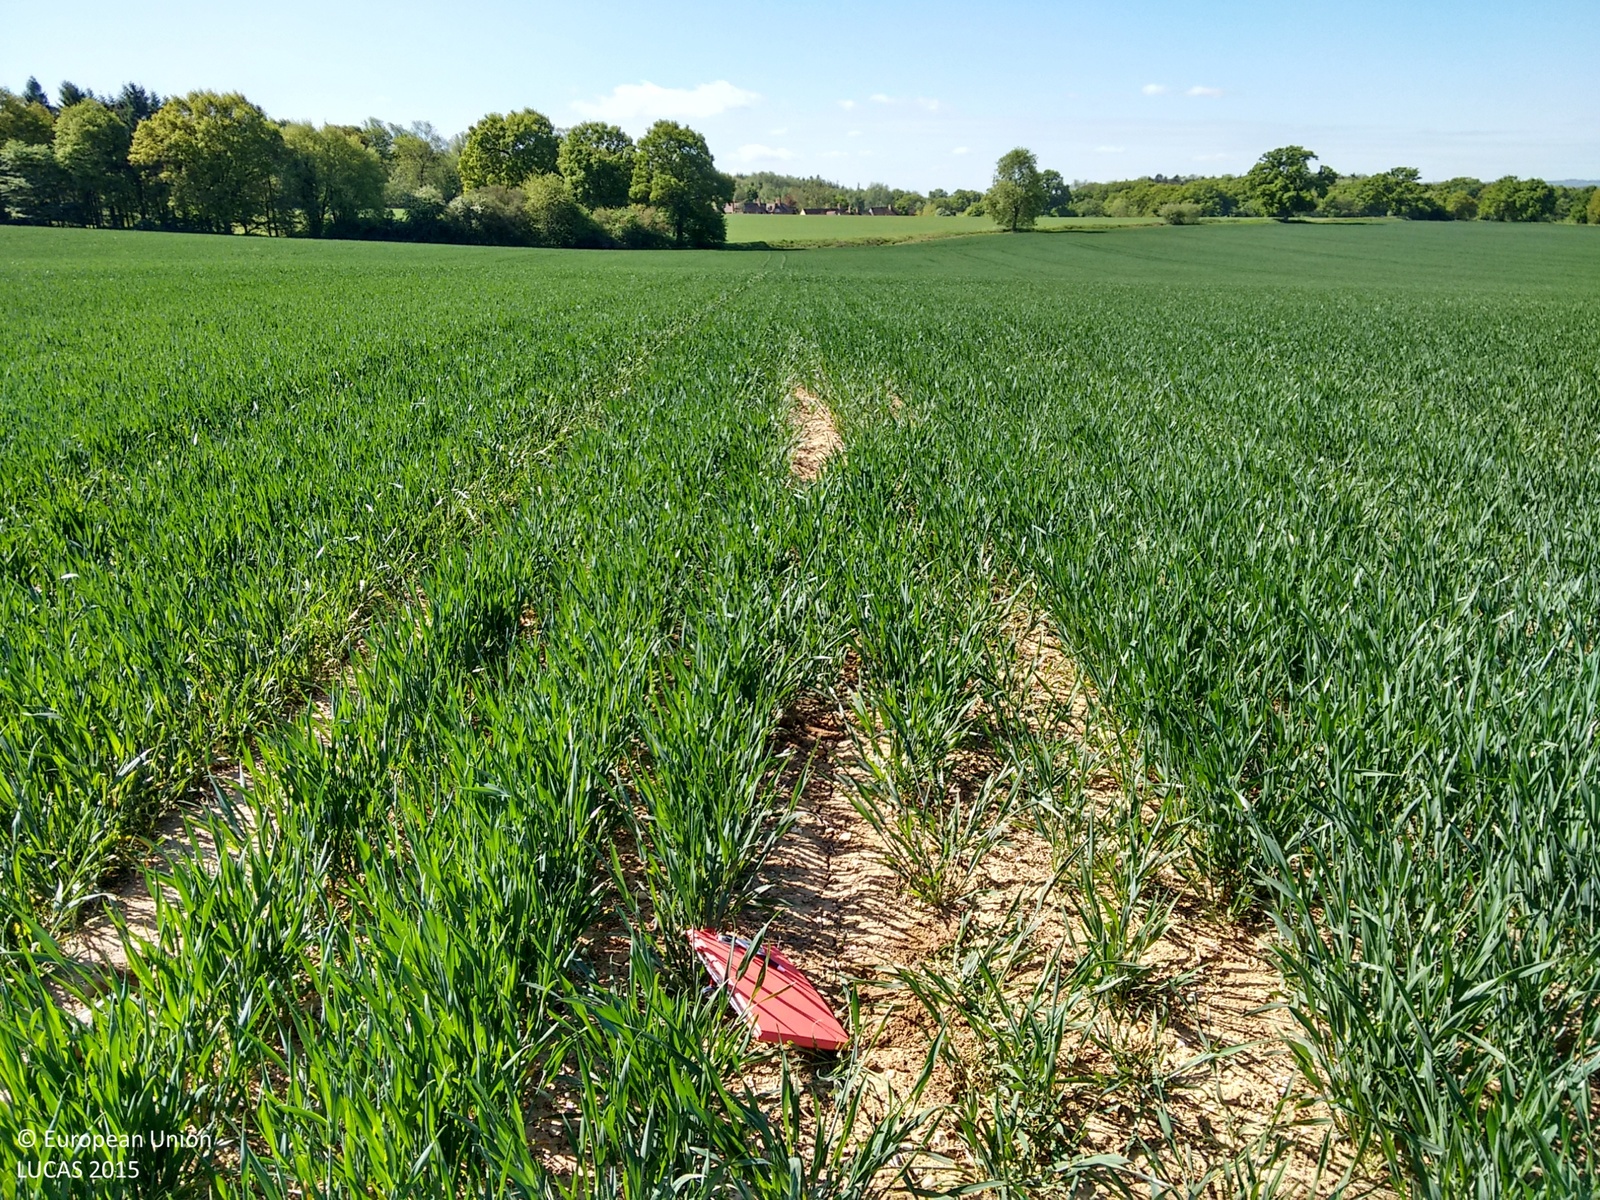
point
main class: Cropland
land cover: Common wheat
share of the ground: 50 - 75 %
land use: Agriculture (excluding fallow land and kitchen gardens)
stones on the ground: < 10 %
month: May
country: GB
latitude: 51.3030
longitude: -0.9885
